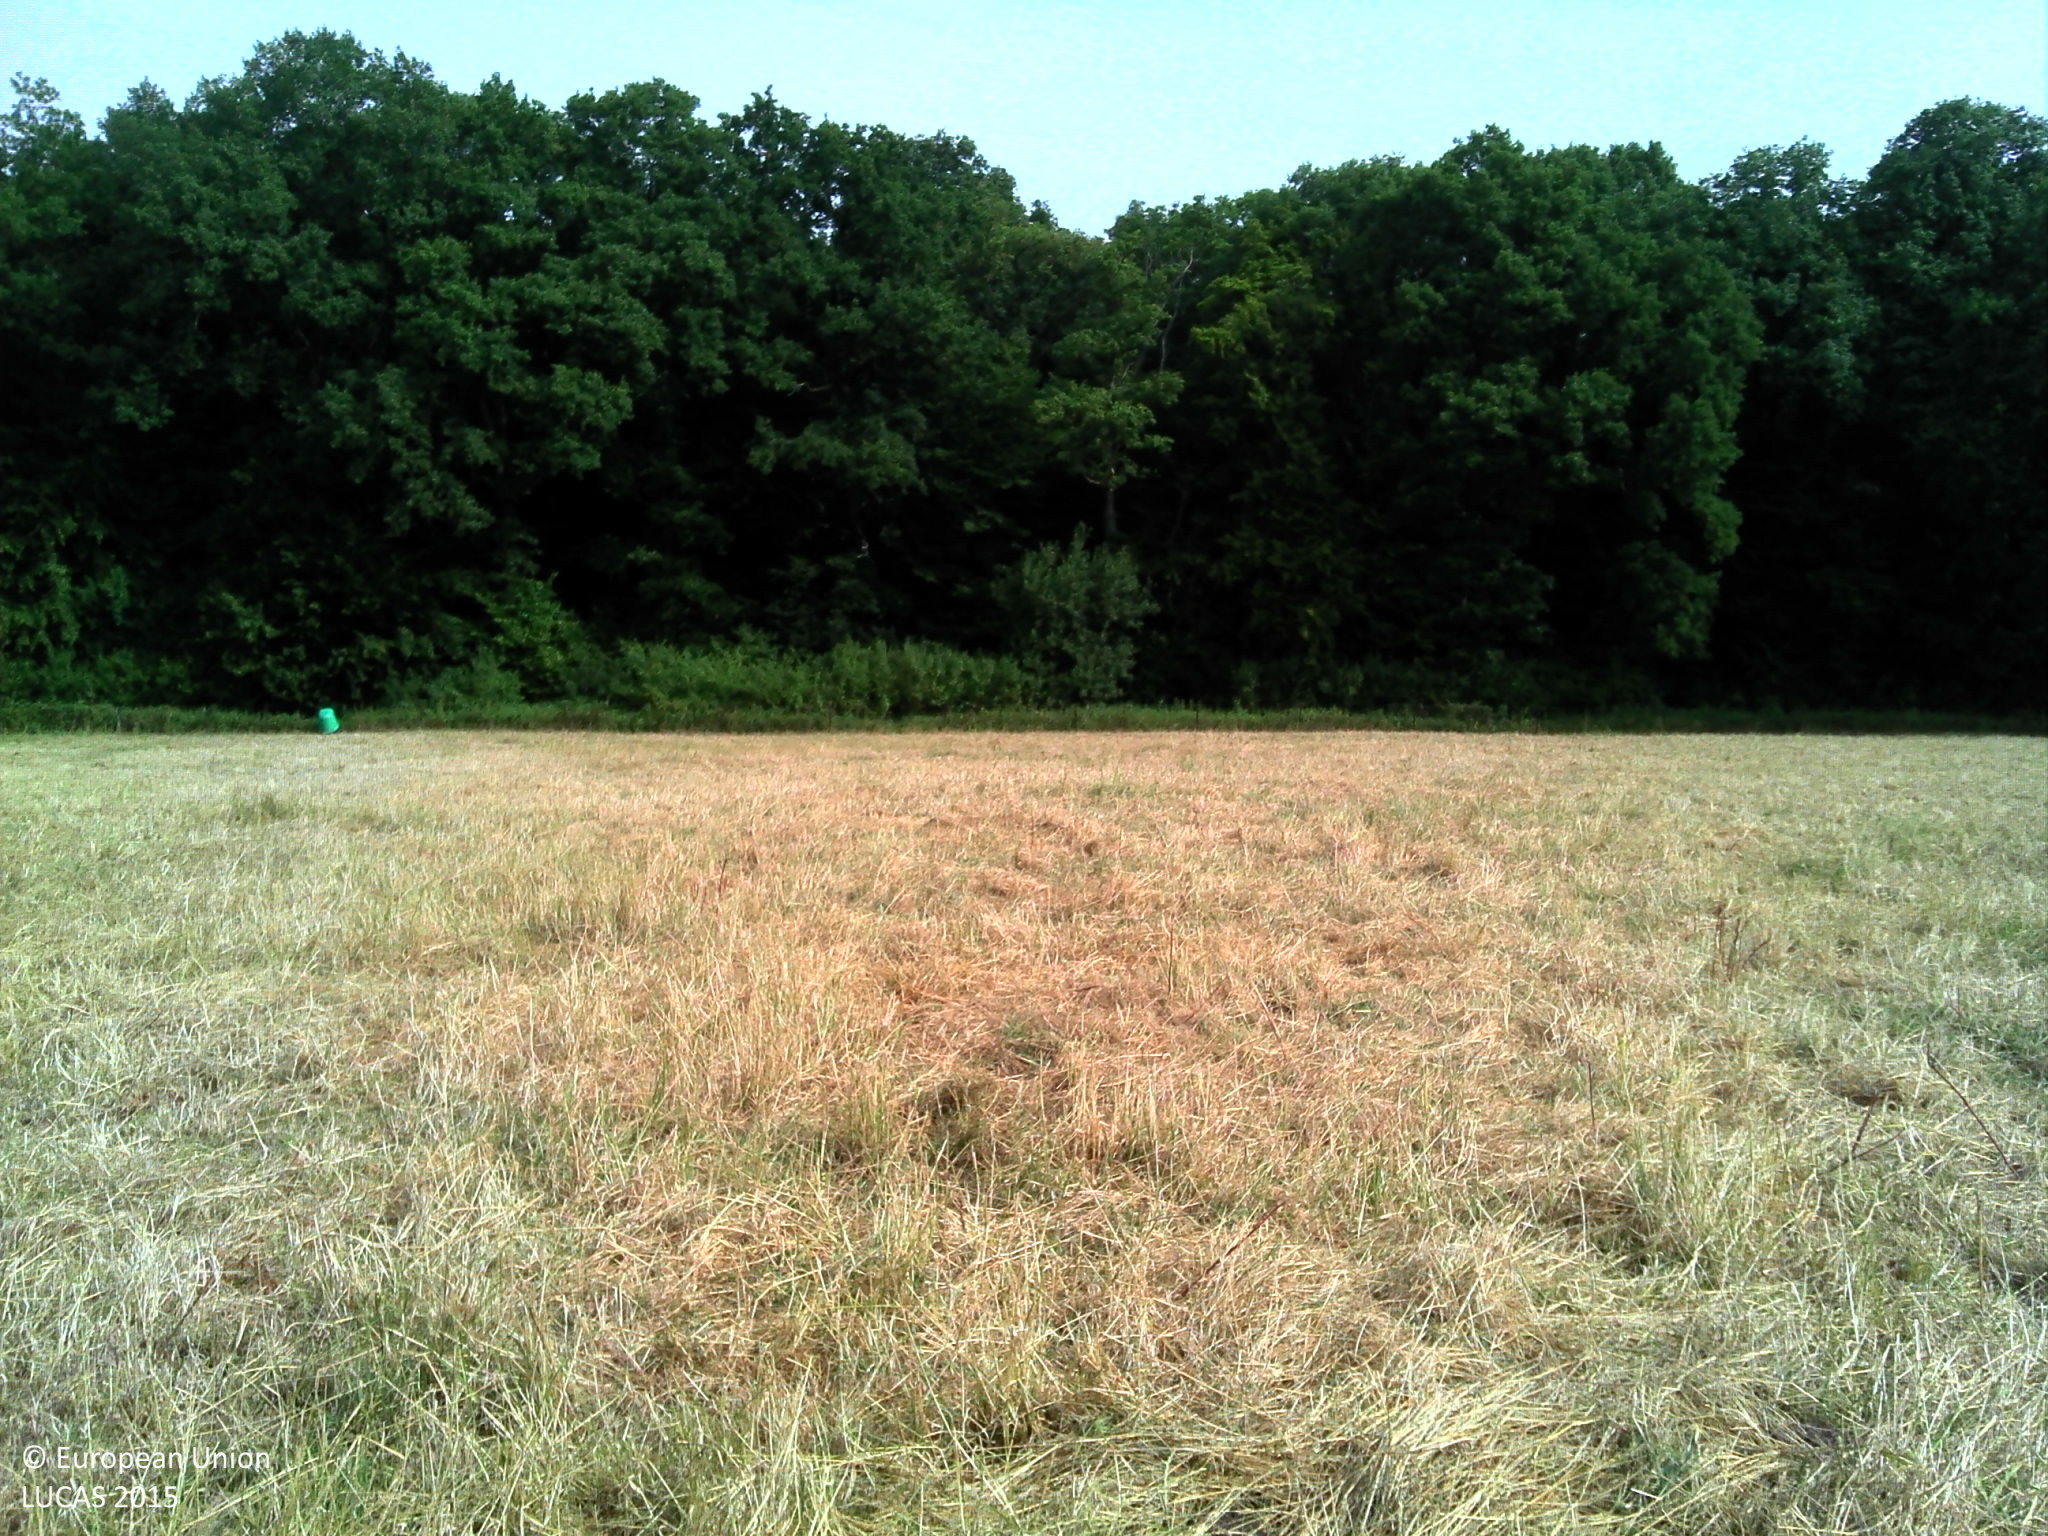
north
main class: Grassland
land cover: Grassland without tree/shrub cover
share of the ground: > 75 %
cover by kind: herbaceous plants 100 %
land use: Agriculture (excluding fallow land and kitchen gardens)
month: July
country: BE
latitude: 49.7476
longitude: 5.8216
